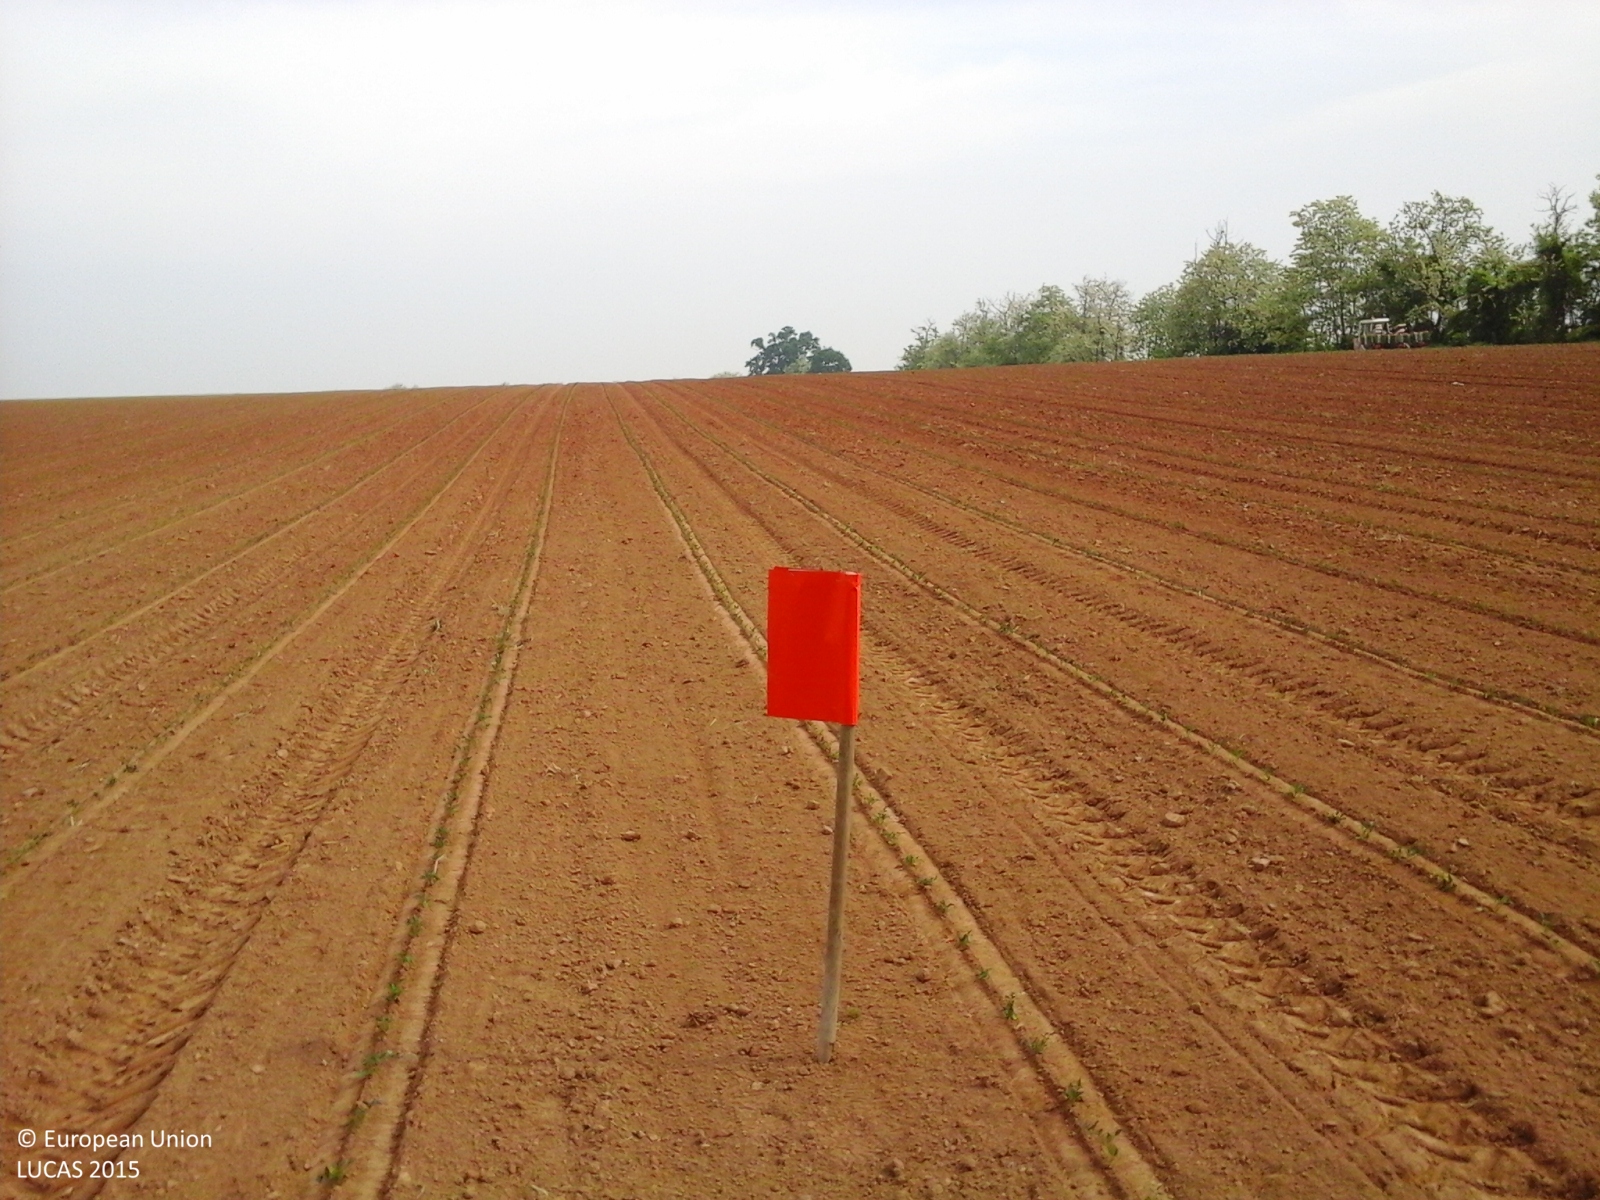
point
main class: Cropland
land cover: Tomatoes
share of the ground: 10 - 25 %
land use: Agriculture (excluding fallow land and kitchen gardens)
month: May
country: IT
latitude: 44.9451
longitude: 9.6585
